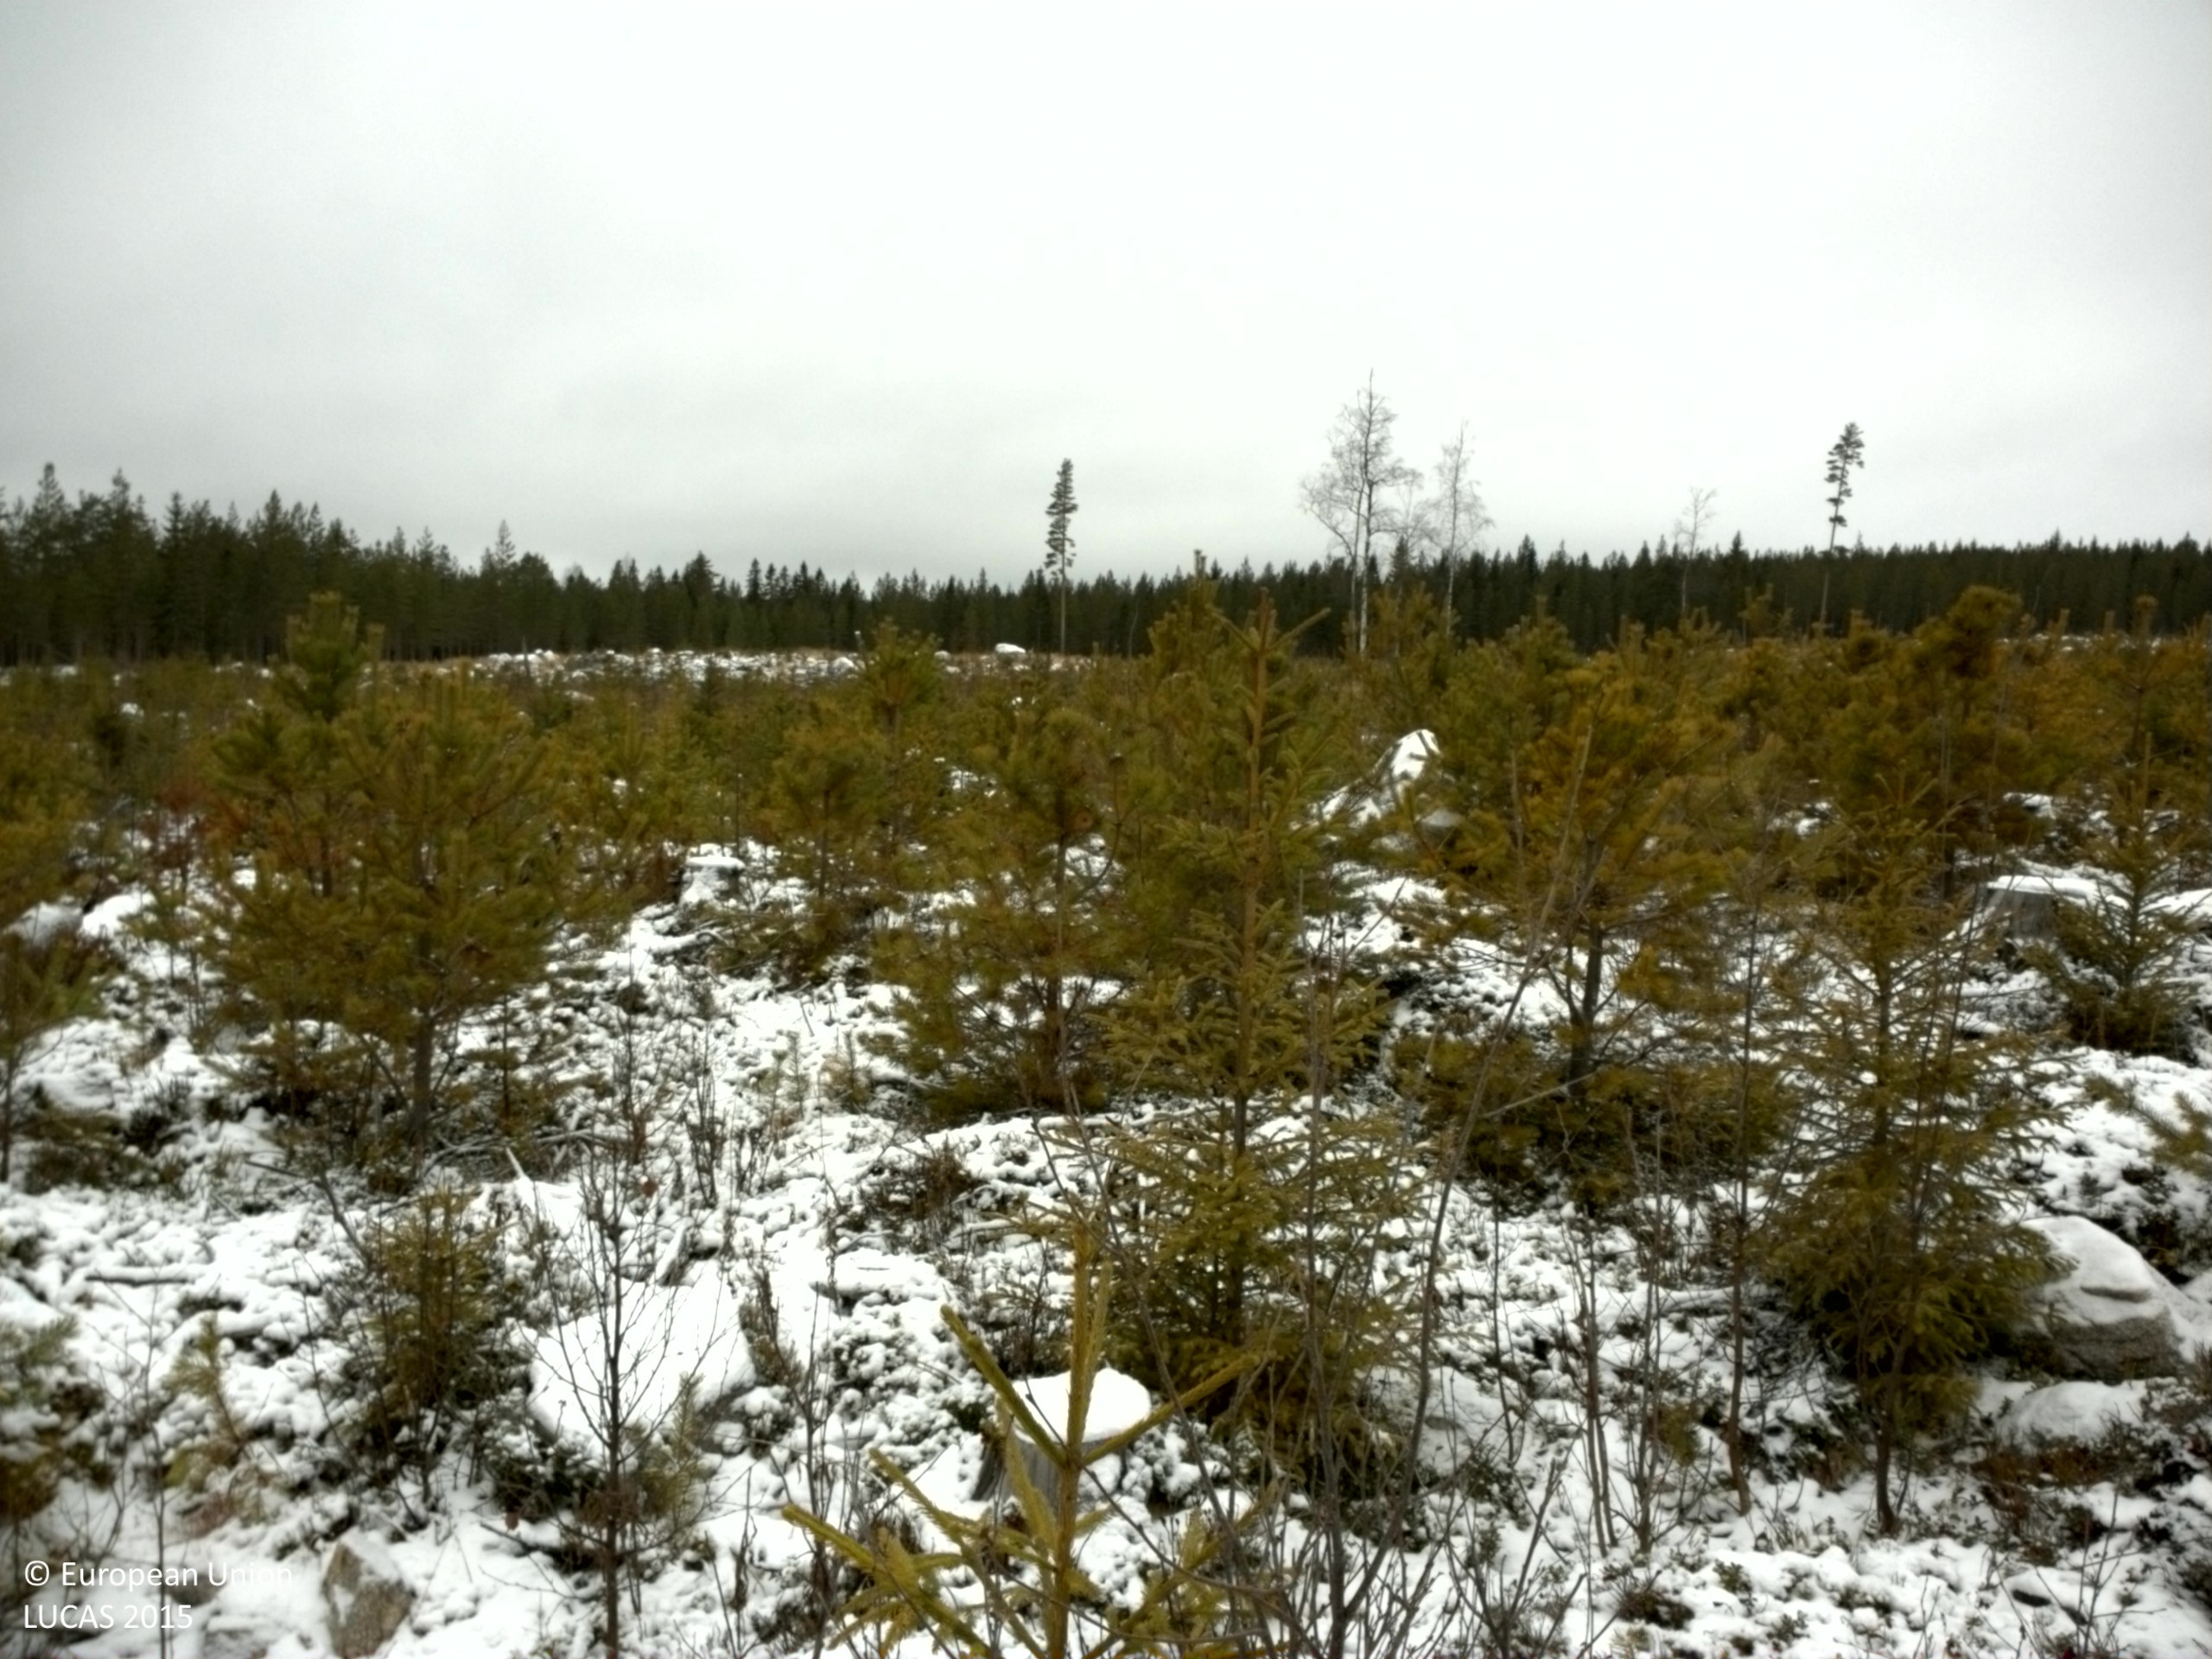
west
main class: Woodland
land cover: Other coniferous woodland
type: boreal forest
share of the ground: 25 - 50 %
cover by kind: shrubs 45 %, coniferous forest trees 25 %, lichens and mosses 20 %, broadleaved forest trees 5 %, consolidated bare surface 5 %
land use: Forestry
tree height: < 5 m
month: November
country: SE
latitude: 61.7668
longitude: 15.6107
